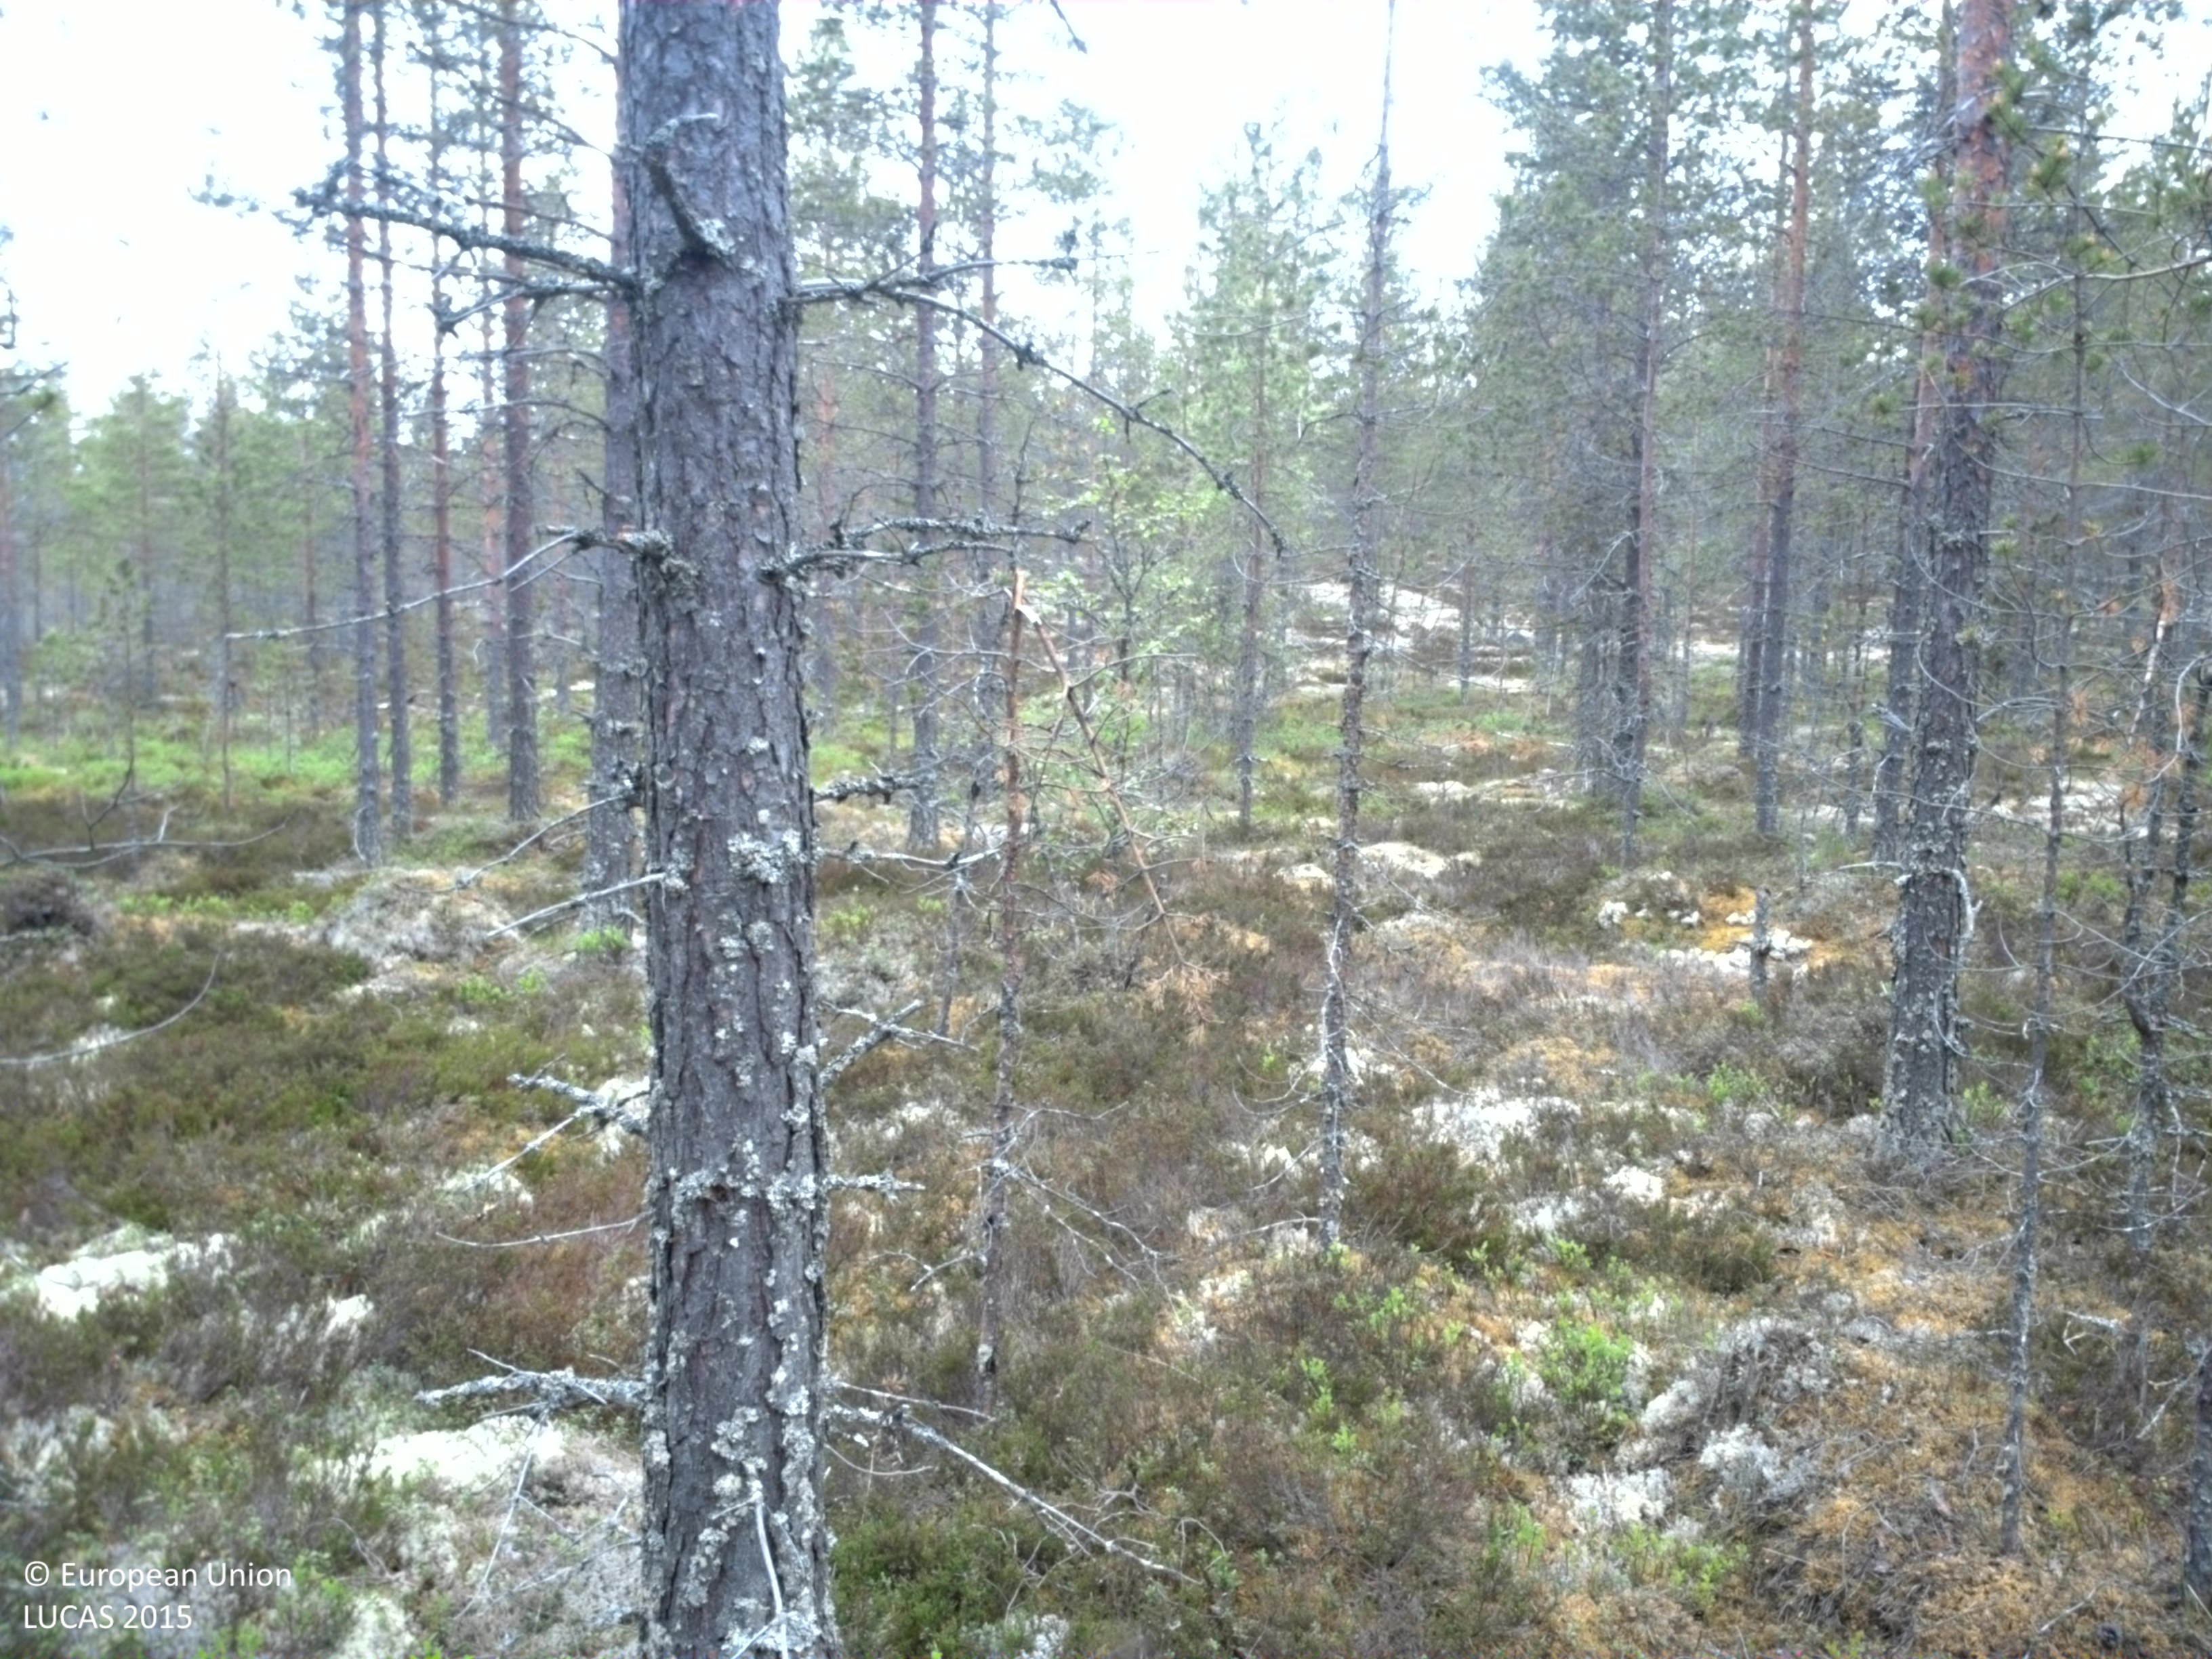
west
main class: Woodland
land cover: Pine dominated coniferous woodland
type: boreal forest
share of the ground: 50 - 75 %
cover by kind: coniferous forest trees 60 %, herbaceous plants 15 %, lichens and mosses 15 %, broadleaved forest trees 10 %
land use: Forestry
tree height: > 5 m
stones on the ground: < 10 %
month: June
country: SE
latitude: 61.1979
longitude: 13.6161
